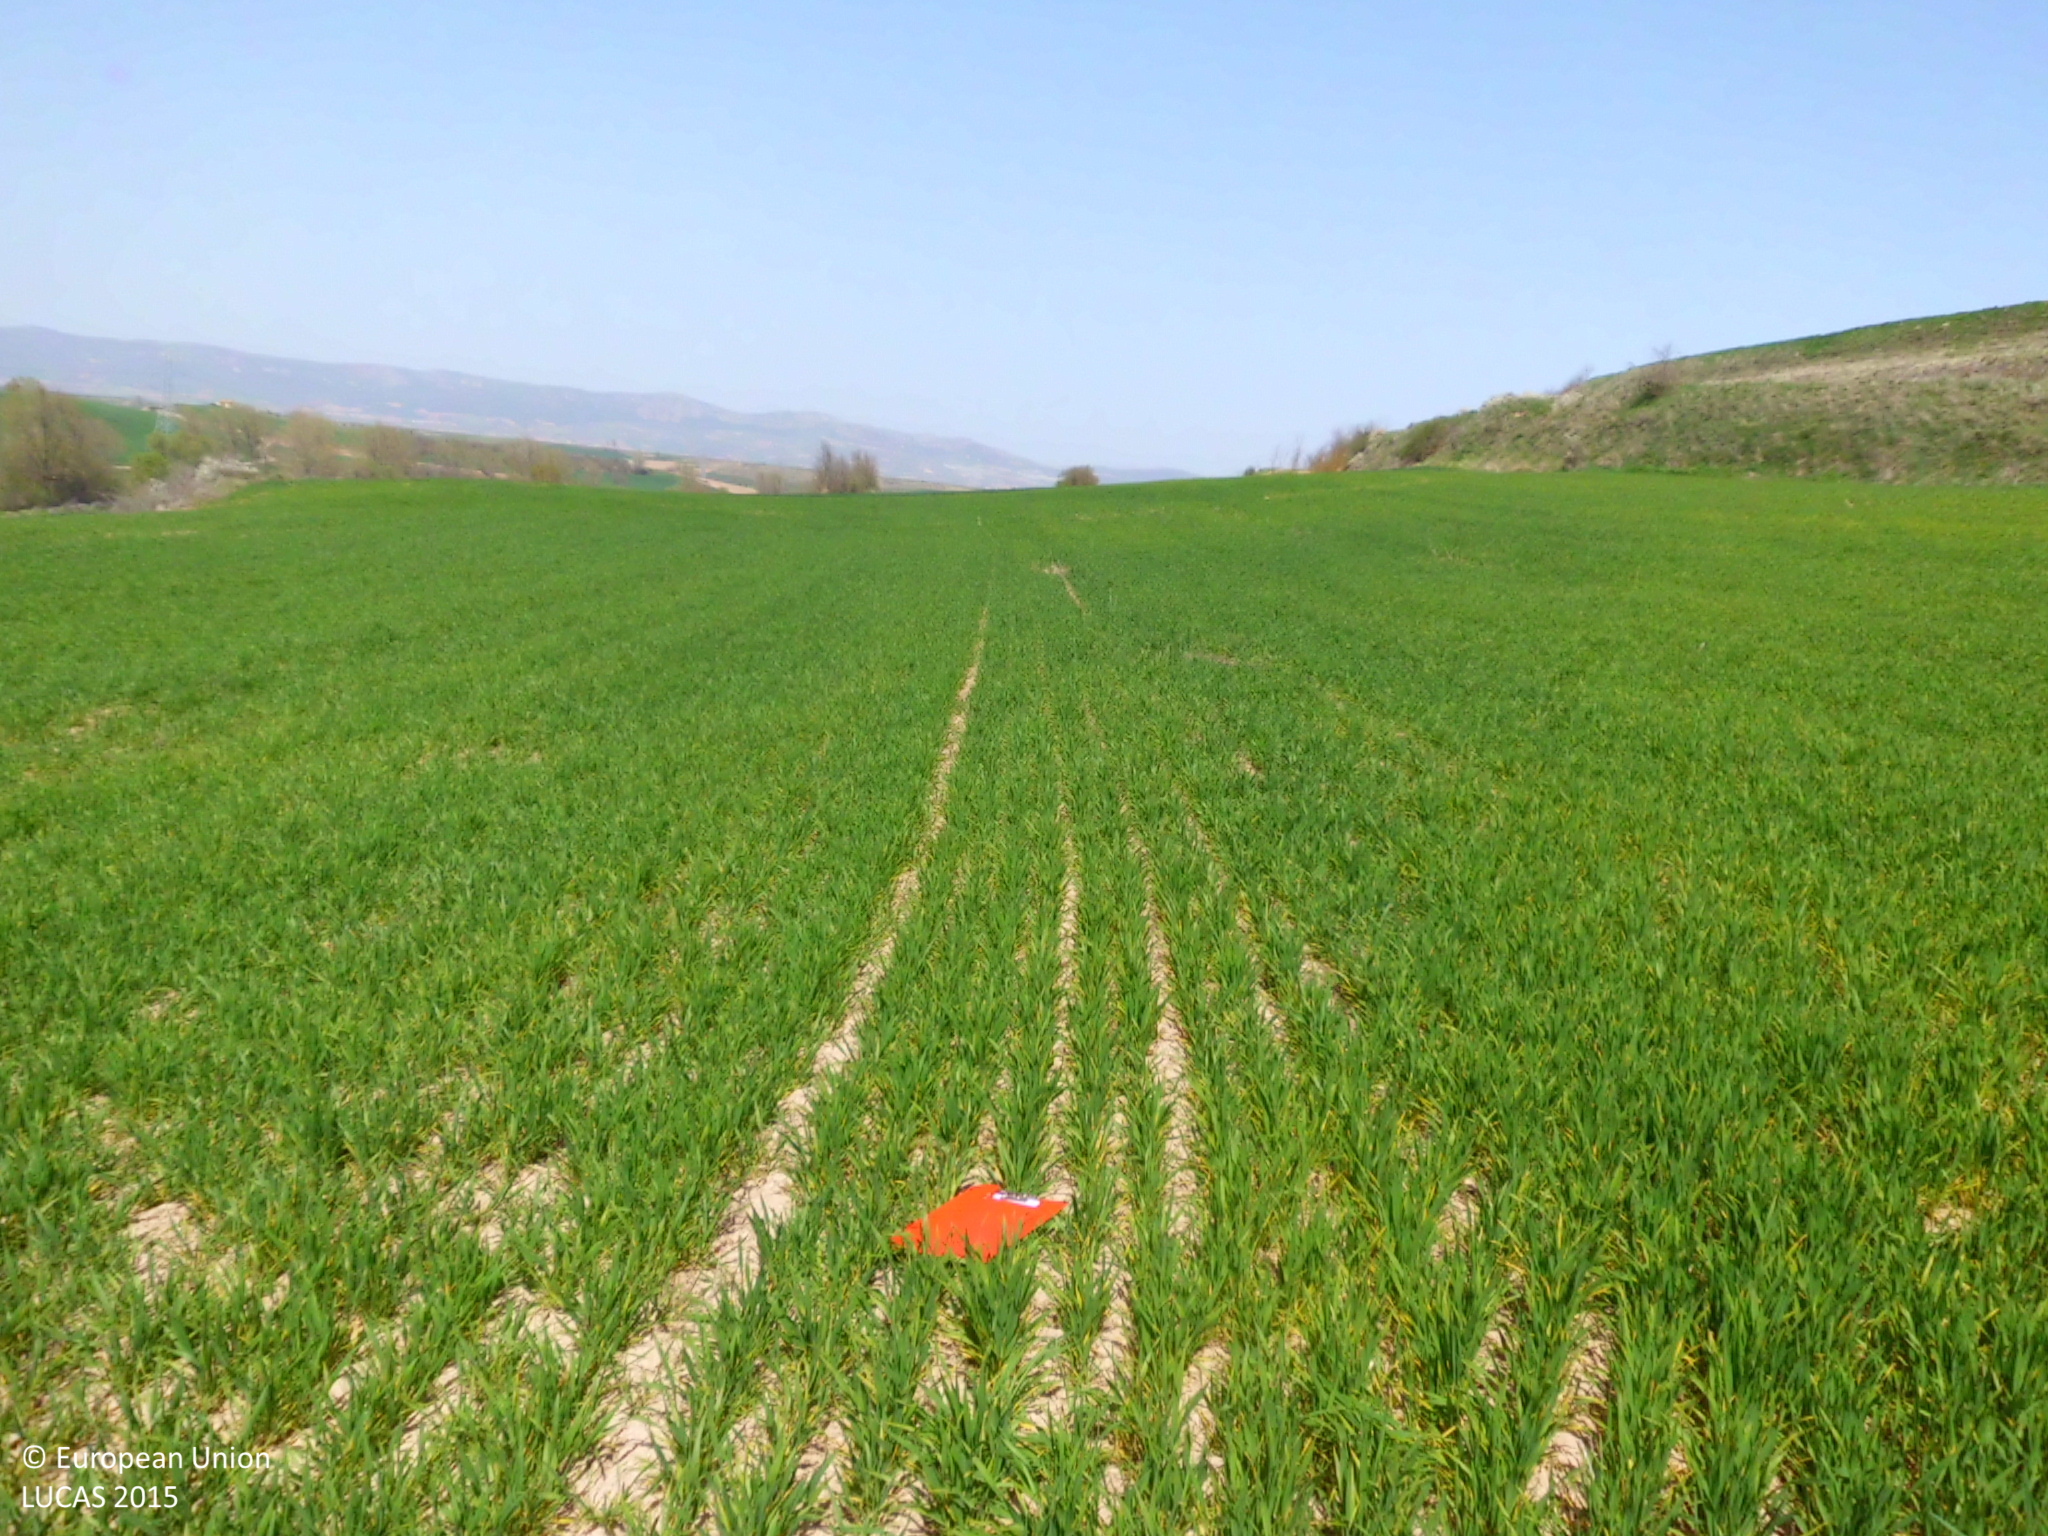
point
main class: Cropland
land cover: Barley
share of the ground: 50 - 75 %
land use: Agriculture (excluding fallow land and kitchen gardens)
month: April
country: ES
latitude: 42.5735
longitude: -3.3245
